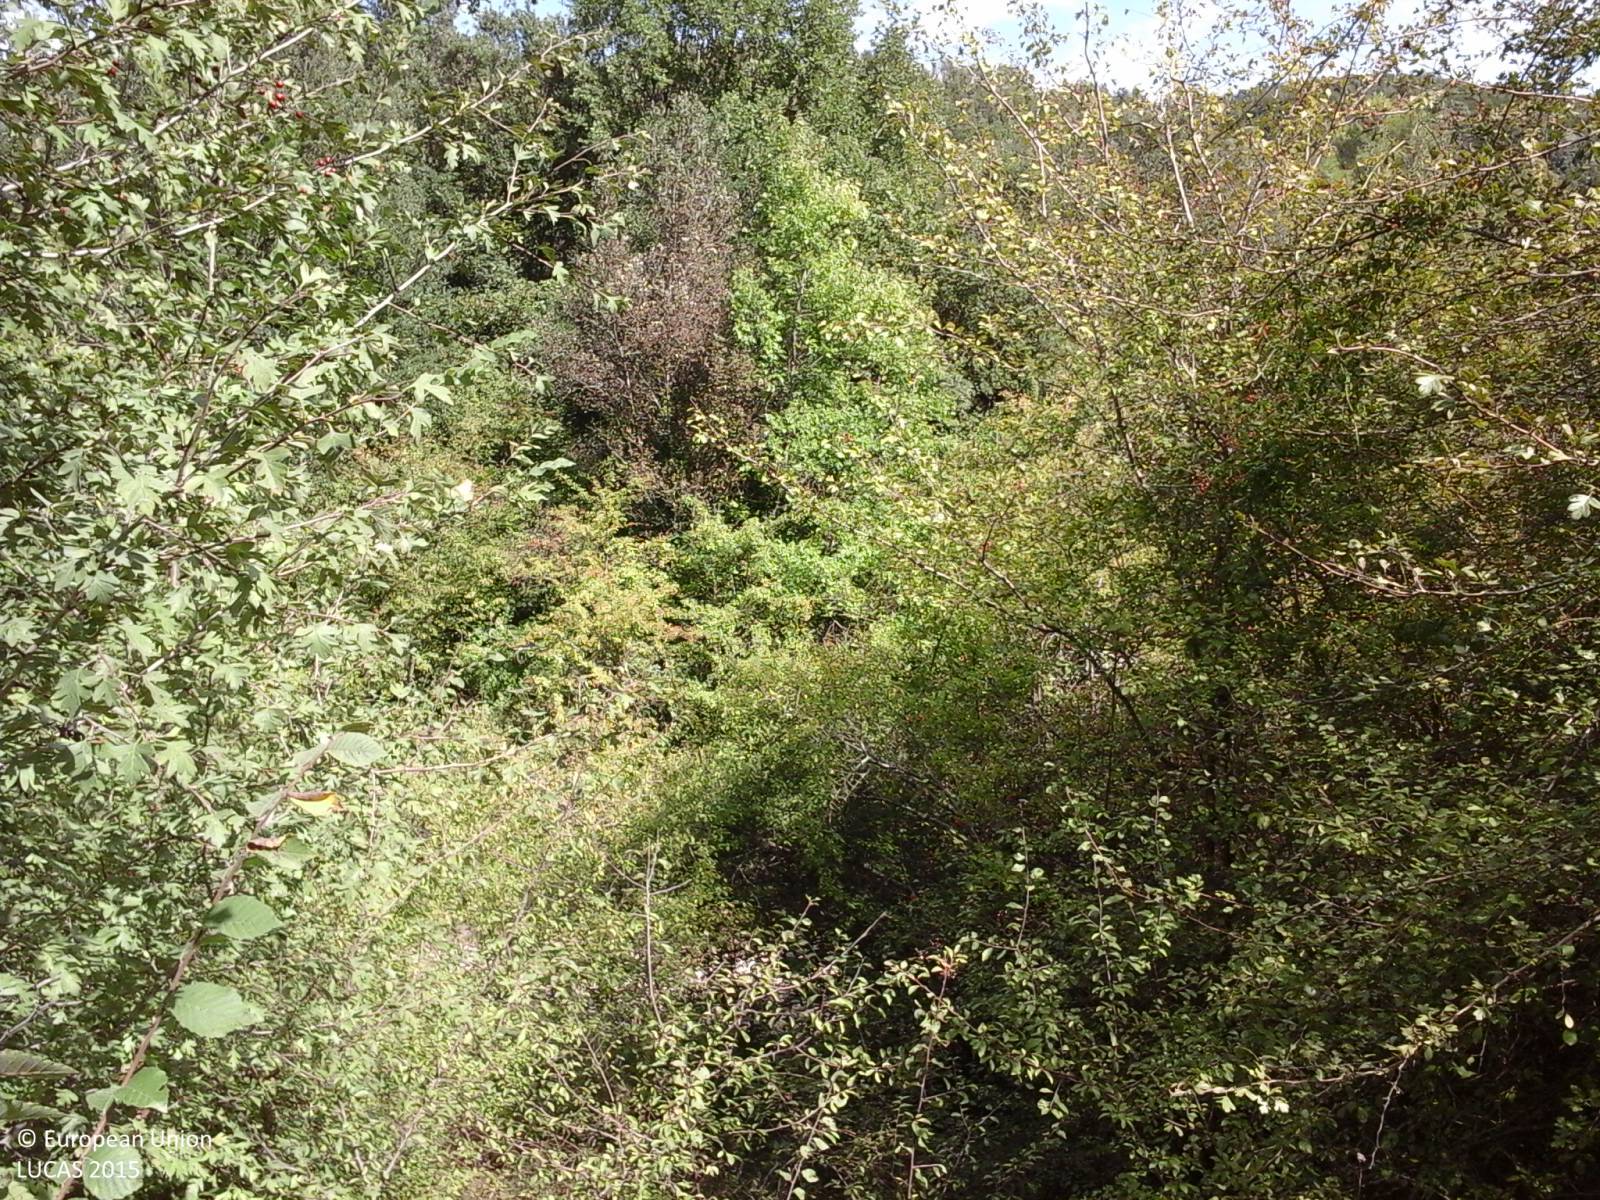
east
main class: Shrubland
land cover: Shrubland with sparse tree cover
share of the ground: > 75 %
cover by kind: shrubs 95 %, broadleaved forest trees 5 %
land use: Abandoned areas
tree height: < 5 m
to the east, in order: Shrubland with sparse tree cover; Tracks; Broadleaved woodland
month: September
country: IT
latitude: 42.3857
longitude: 12.6027
